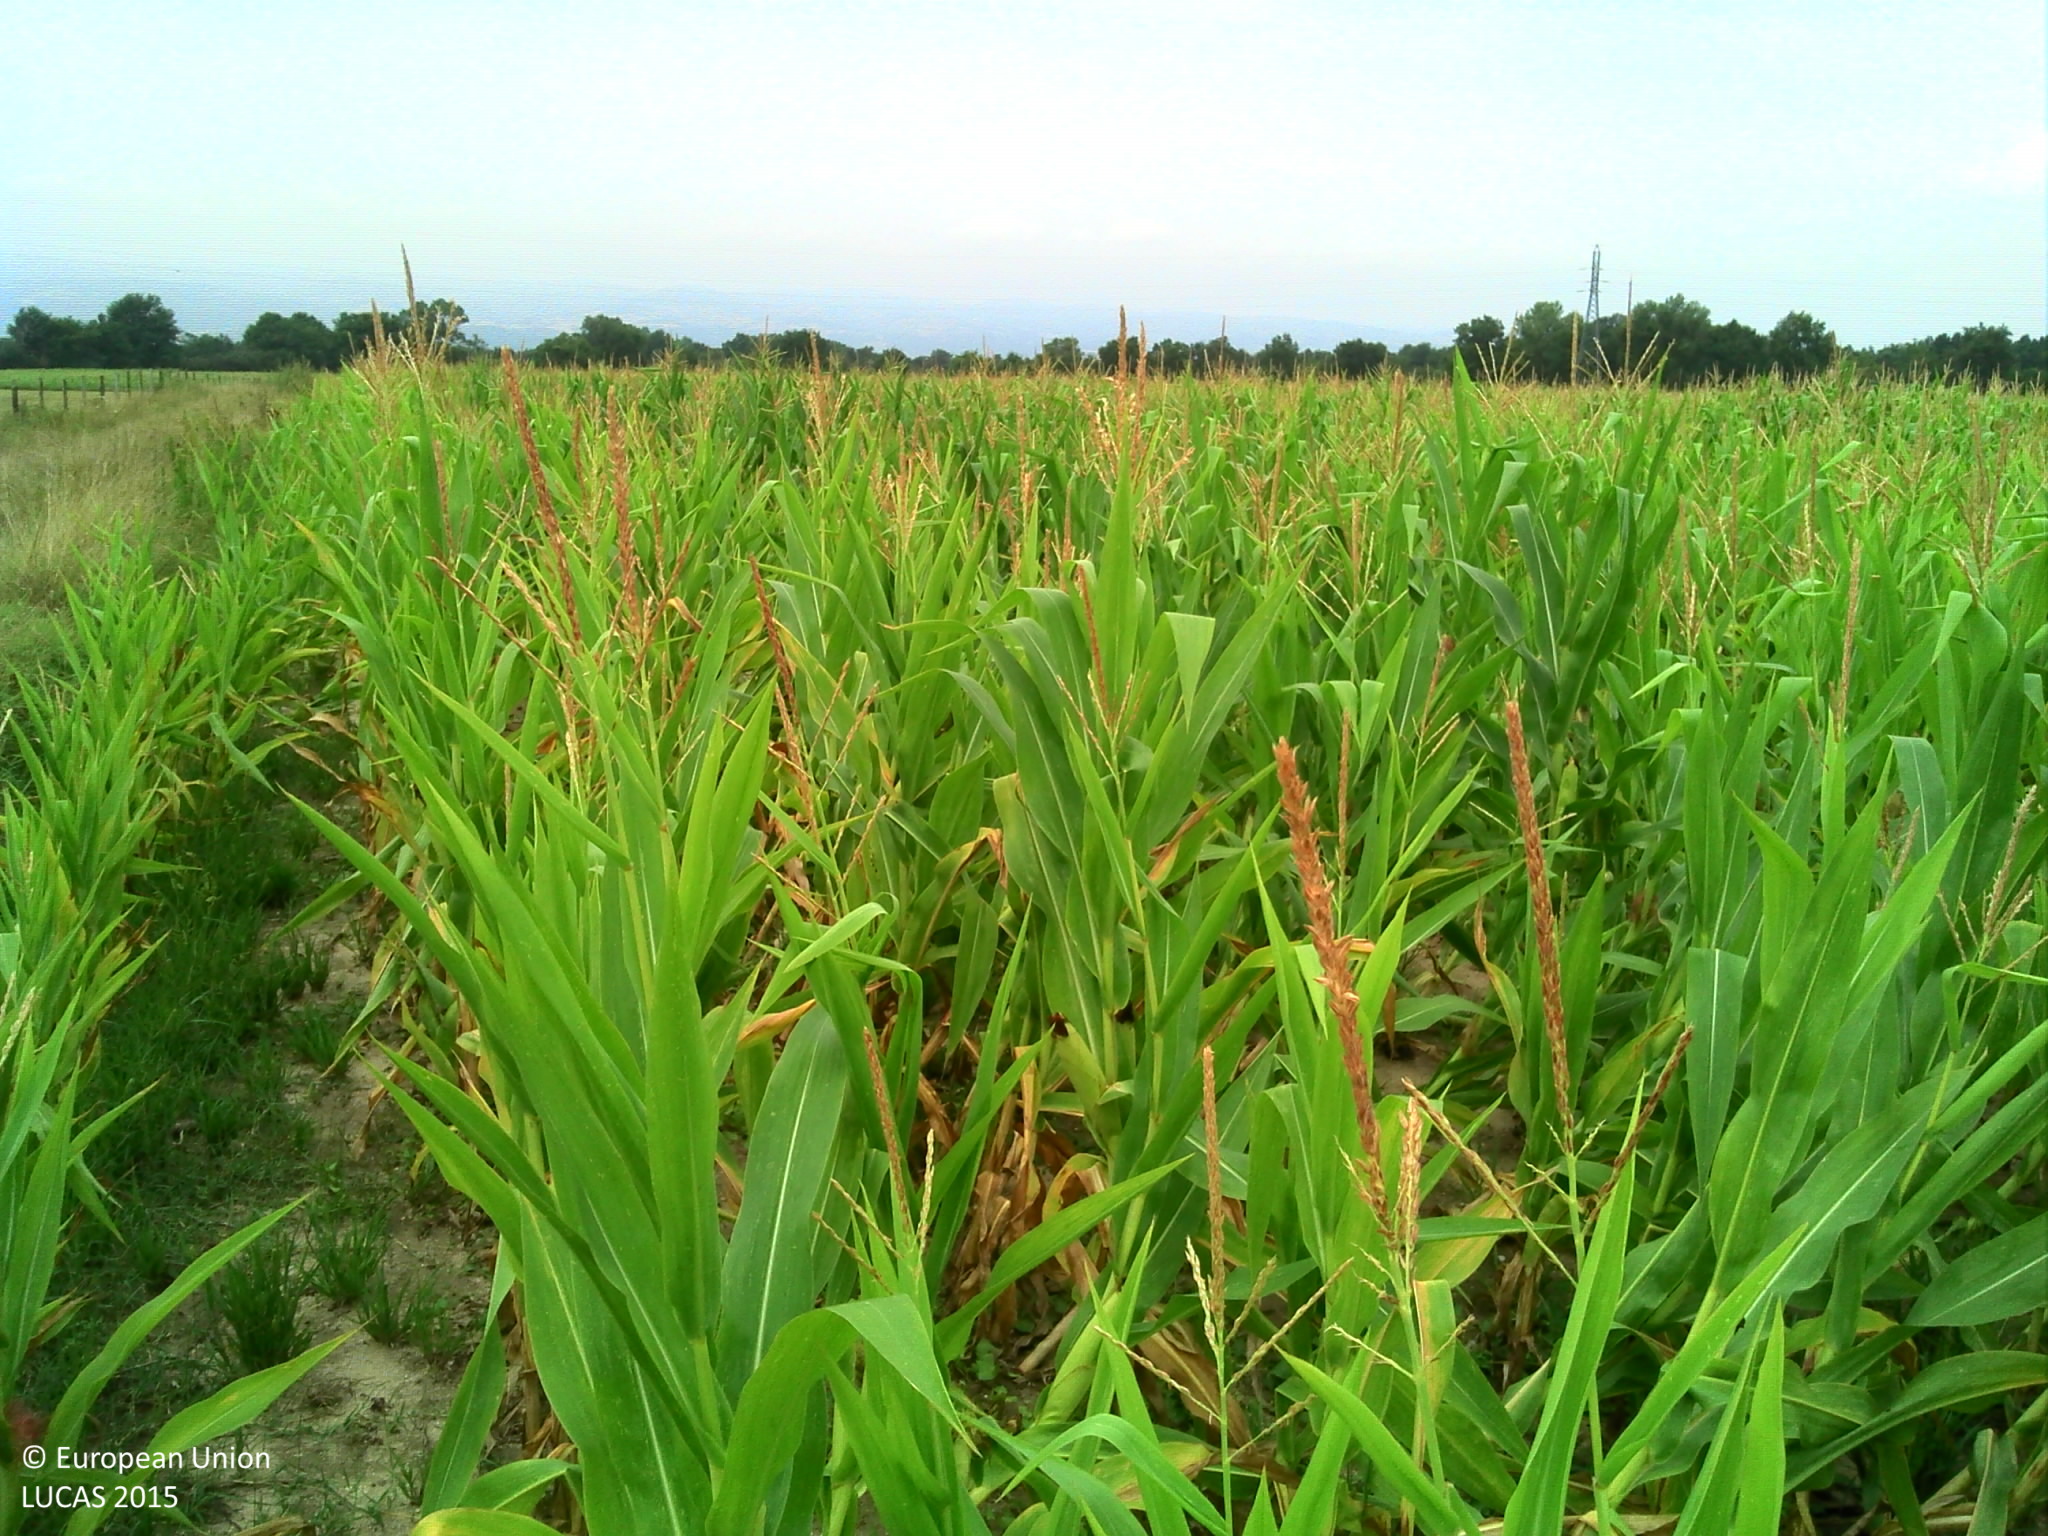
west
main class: Cropland
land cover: Maize
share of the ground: 50 - 75 %
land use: Agriculture (excluding fallow land and kitchen gardens)
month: August
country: FR
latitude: 45.6307
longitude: 4.1408
